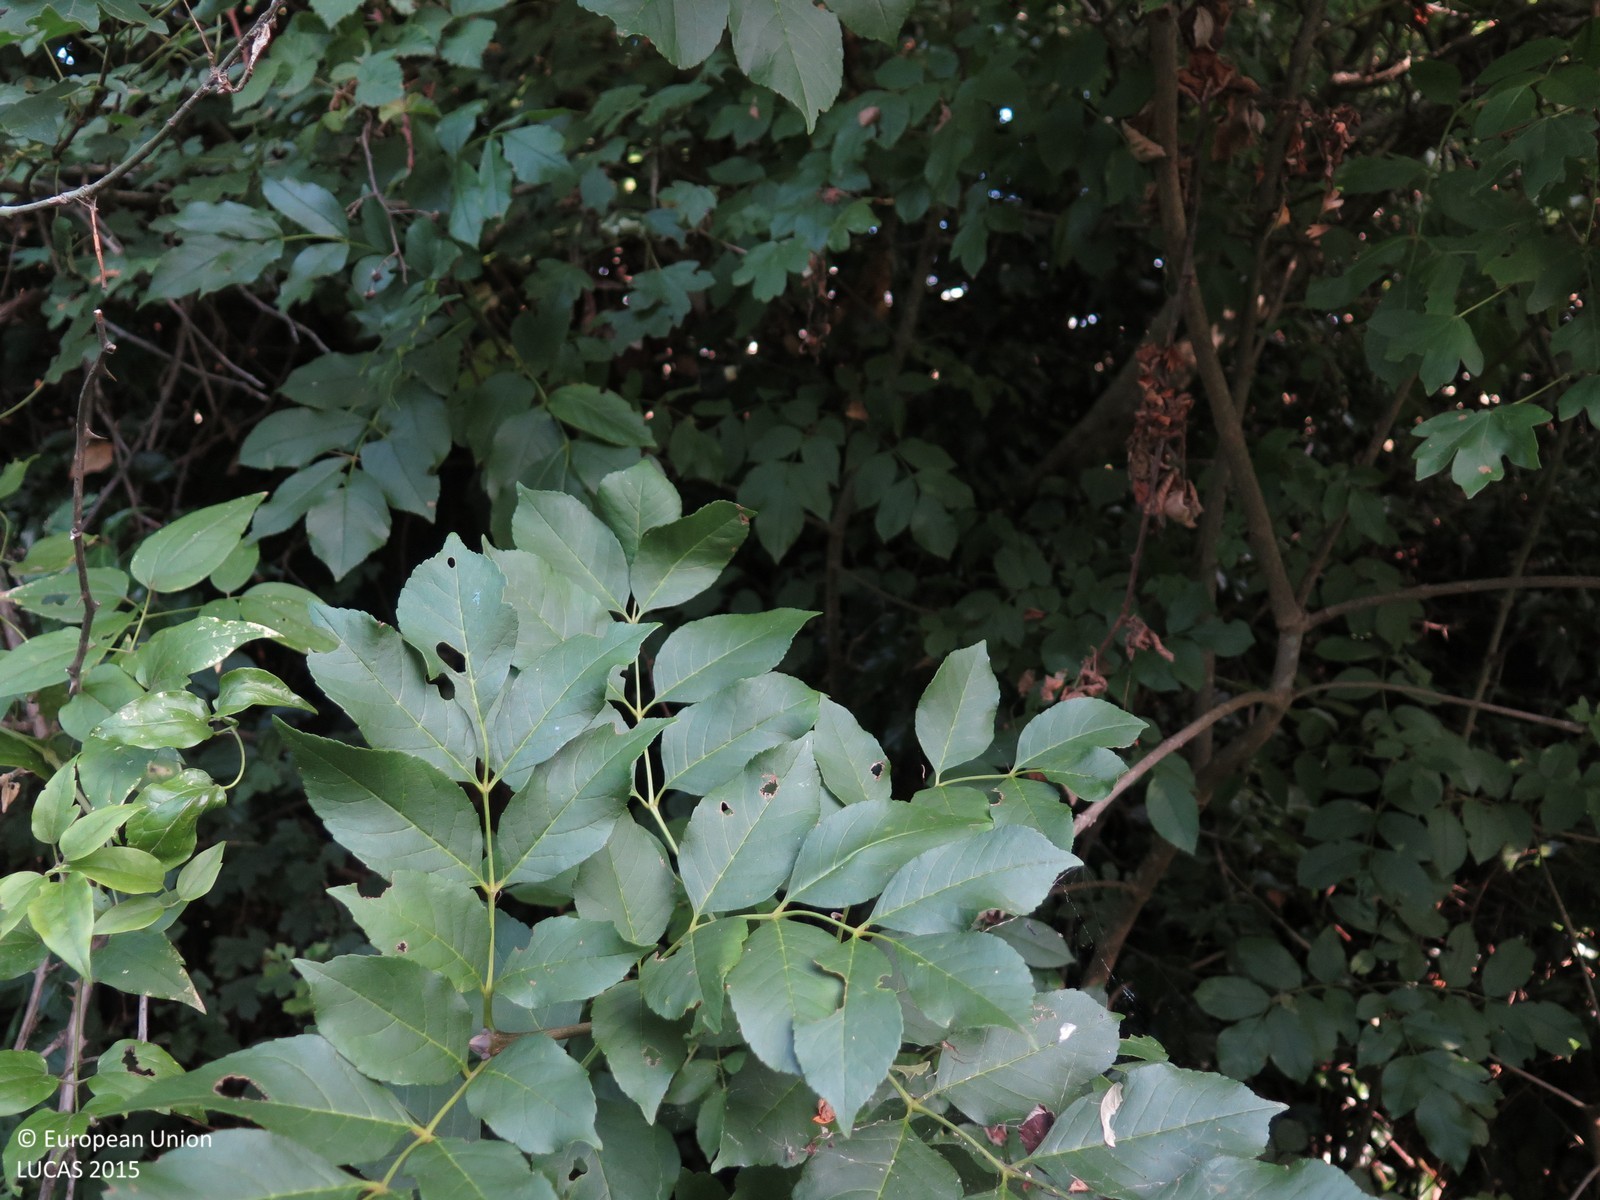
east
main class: Woodland
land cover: Broadleaved woodland
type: mesophytic deciduous forest
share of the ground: > 75 %
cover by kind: broadleaved forest trees 95 %, shrubs 5 %
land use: Semi-natural and natural areas not in use
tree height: > 5 m
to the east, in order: Broadleaved woodland; Dry stone walls; Tracks; Dry stone walls; Broadleaved woodland; Grassland without tree/shrub cover; Broadleaved woodland; Grassland without tree/shrub cover; Abandoned hedges; Dry stone walls; Tracks; Dry stone walls; Abandoned hedges; Grassland without tree/shrub cover
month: June
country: HR
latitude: 45.1456
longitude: 13.8482
